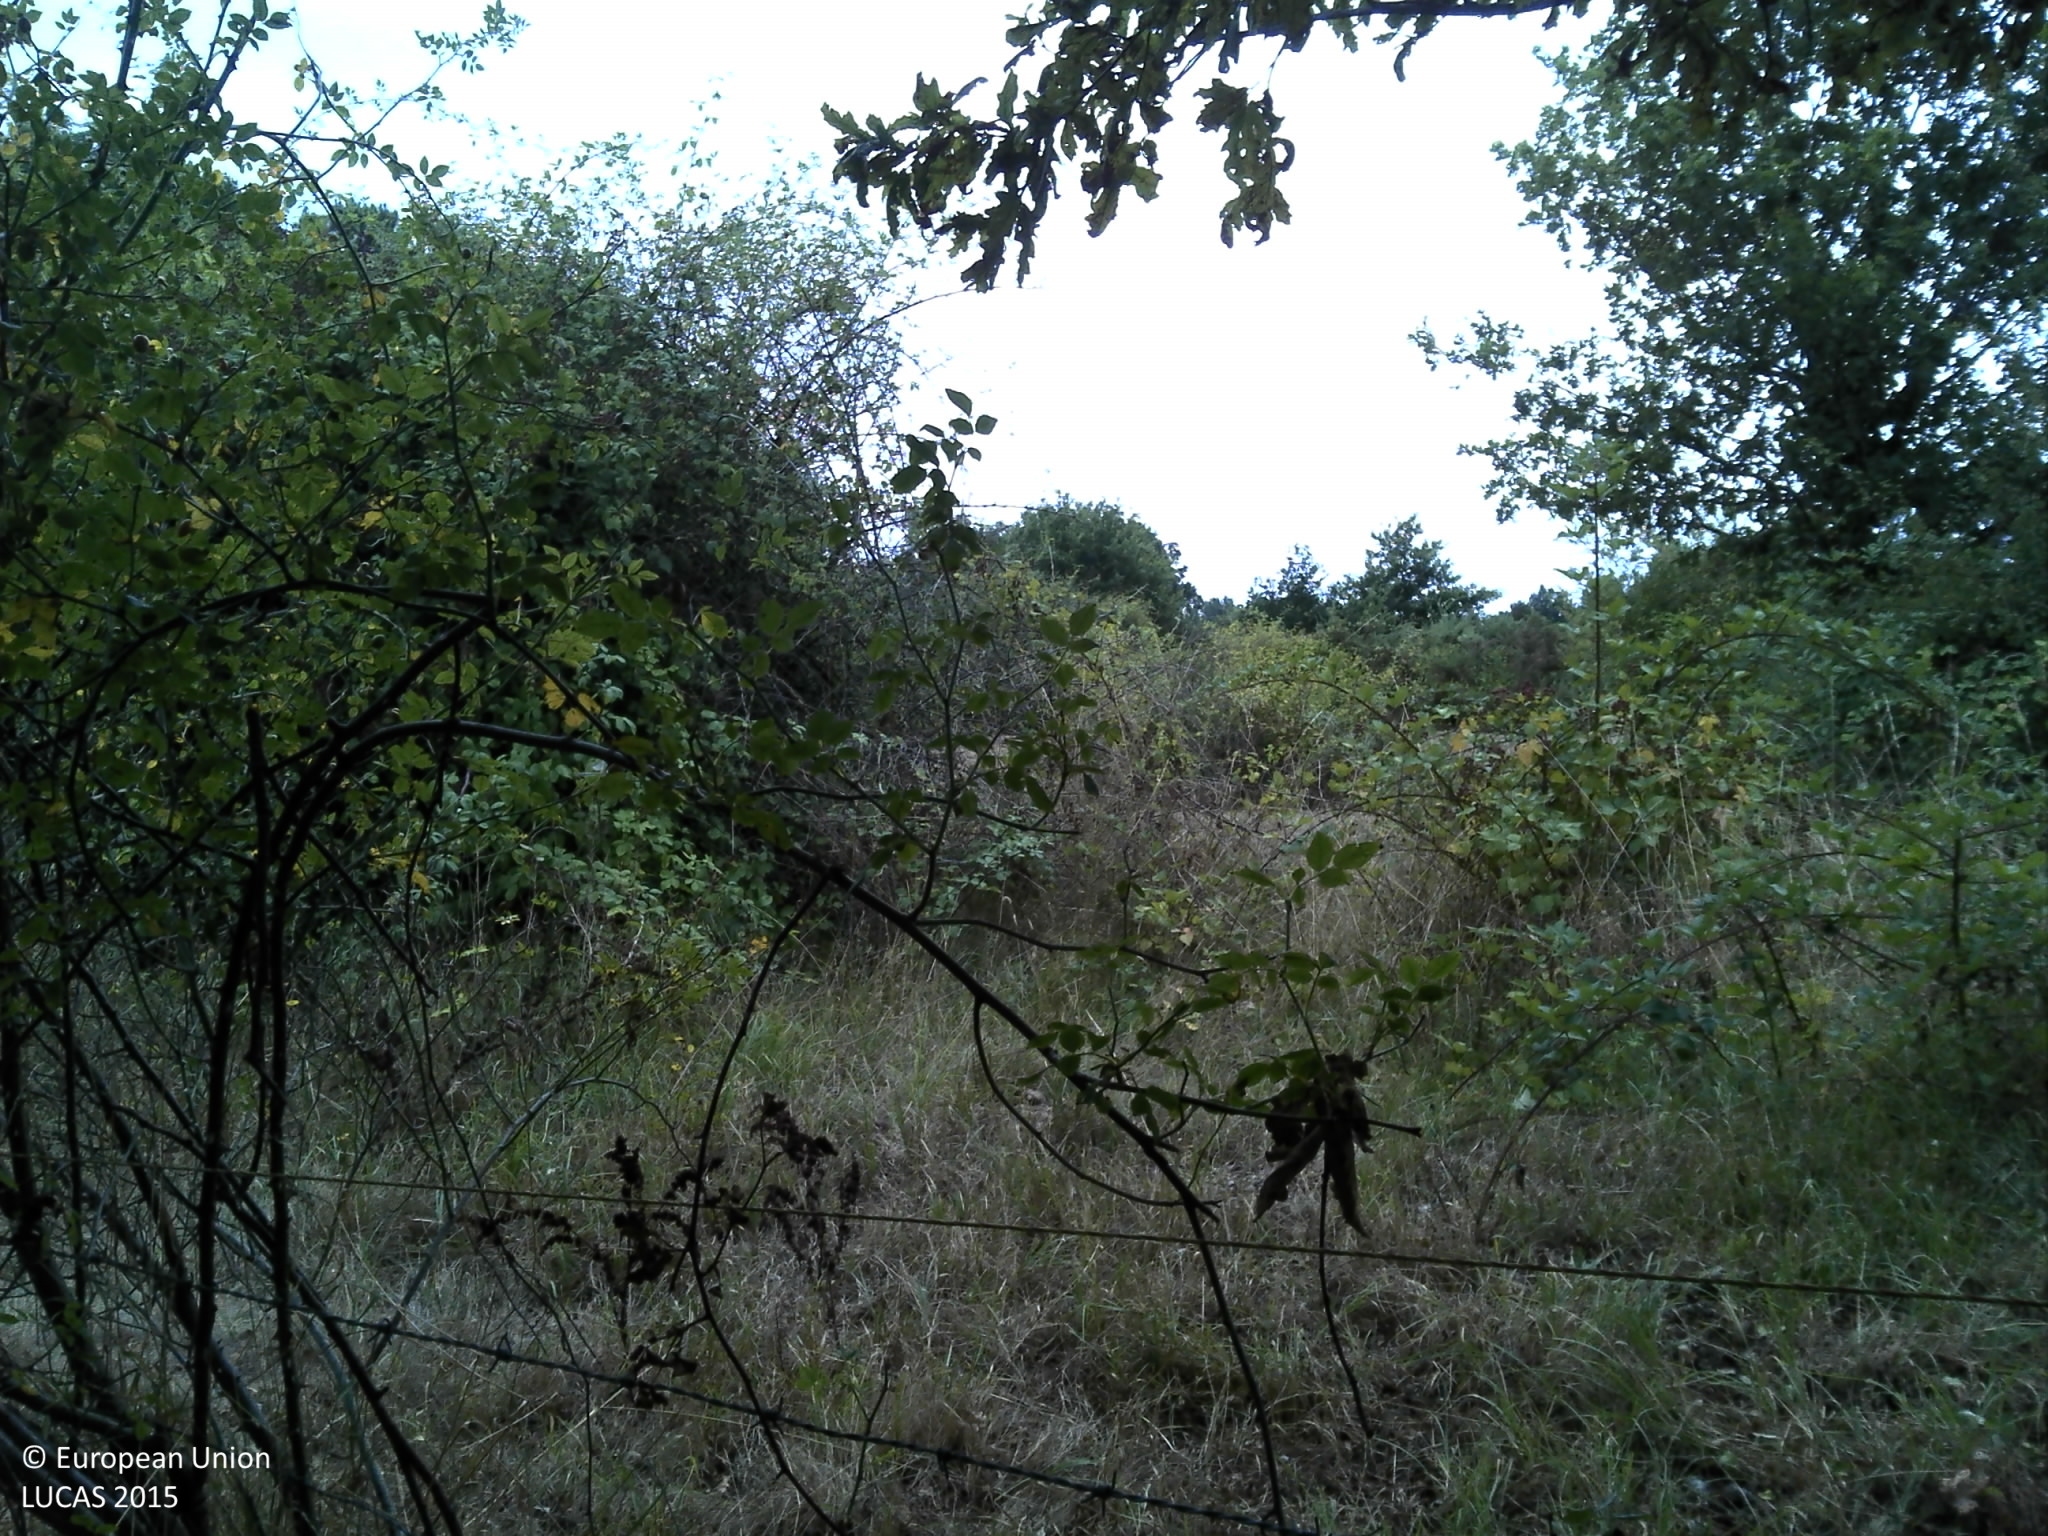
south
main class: Shrubland
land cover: Shrubland with sparse tree cover
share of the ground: > 75 %
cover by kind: herbaceous plants 50 %, shrubs 45 %, broadleaved forest trees 5 %
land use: Agriculture (excluding fallow land and kitchen gardens)
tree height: < 5 m
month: August
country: FR
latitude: 45.1748
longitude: -0.5434
